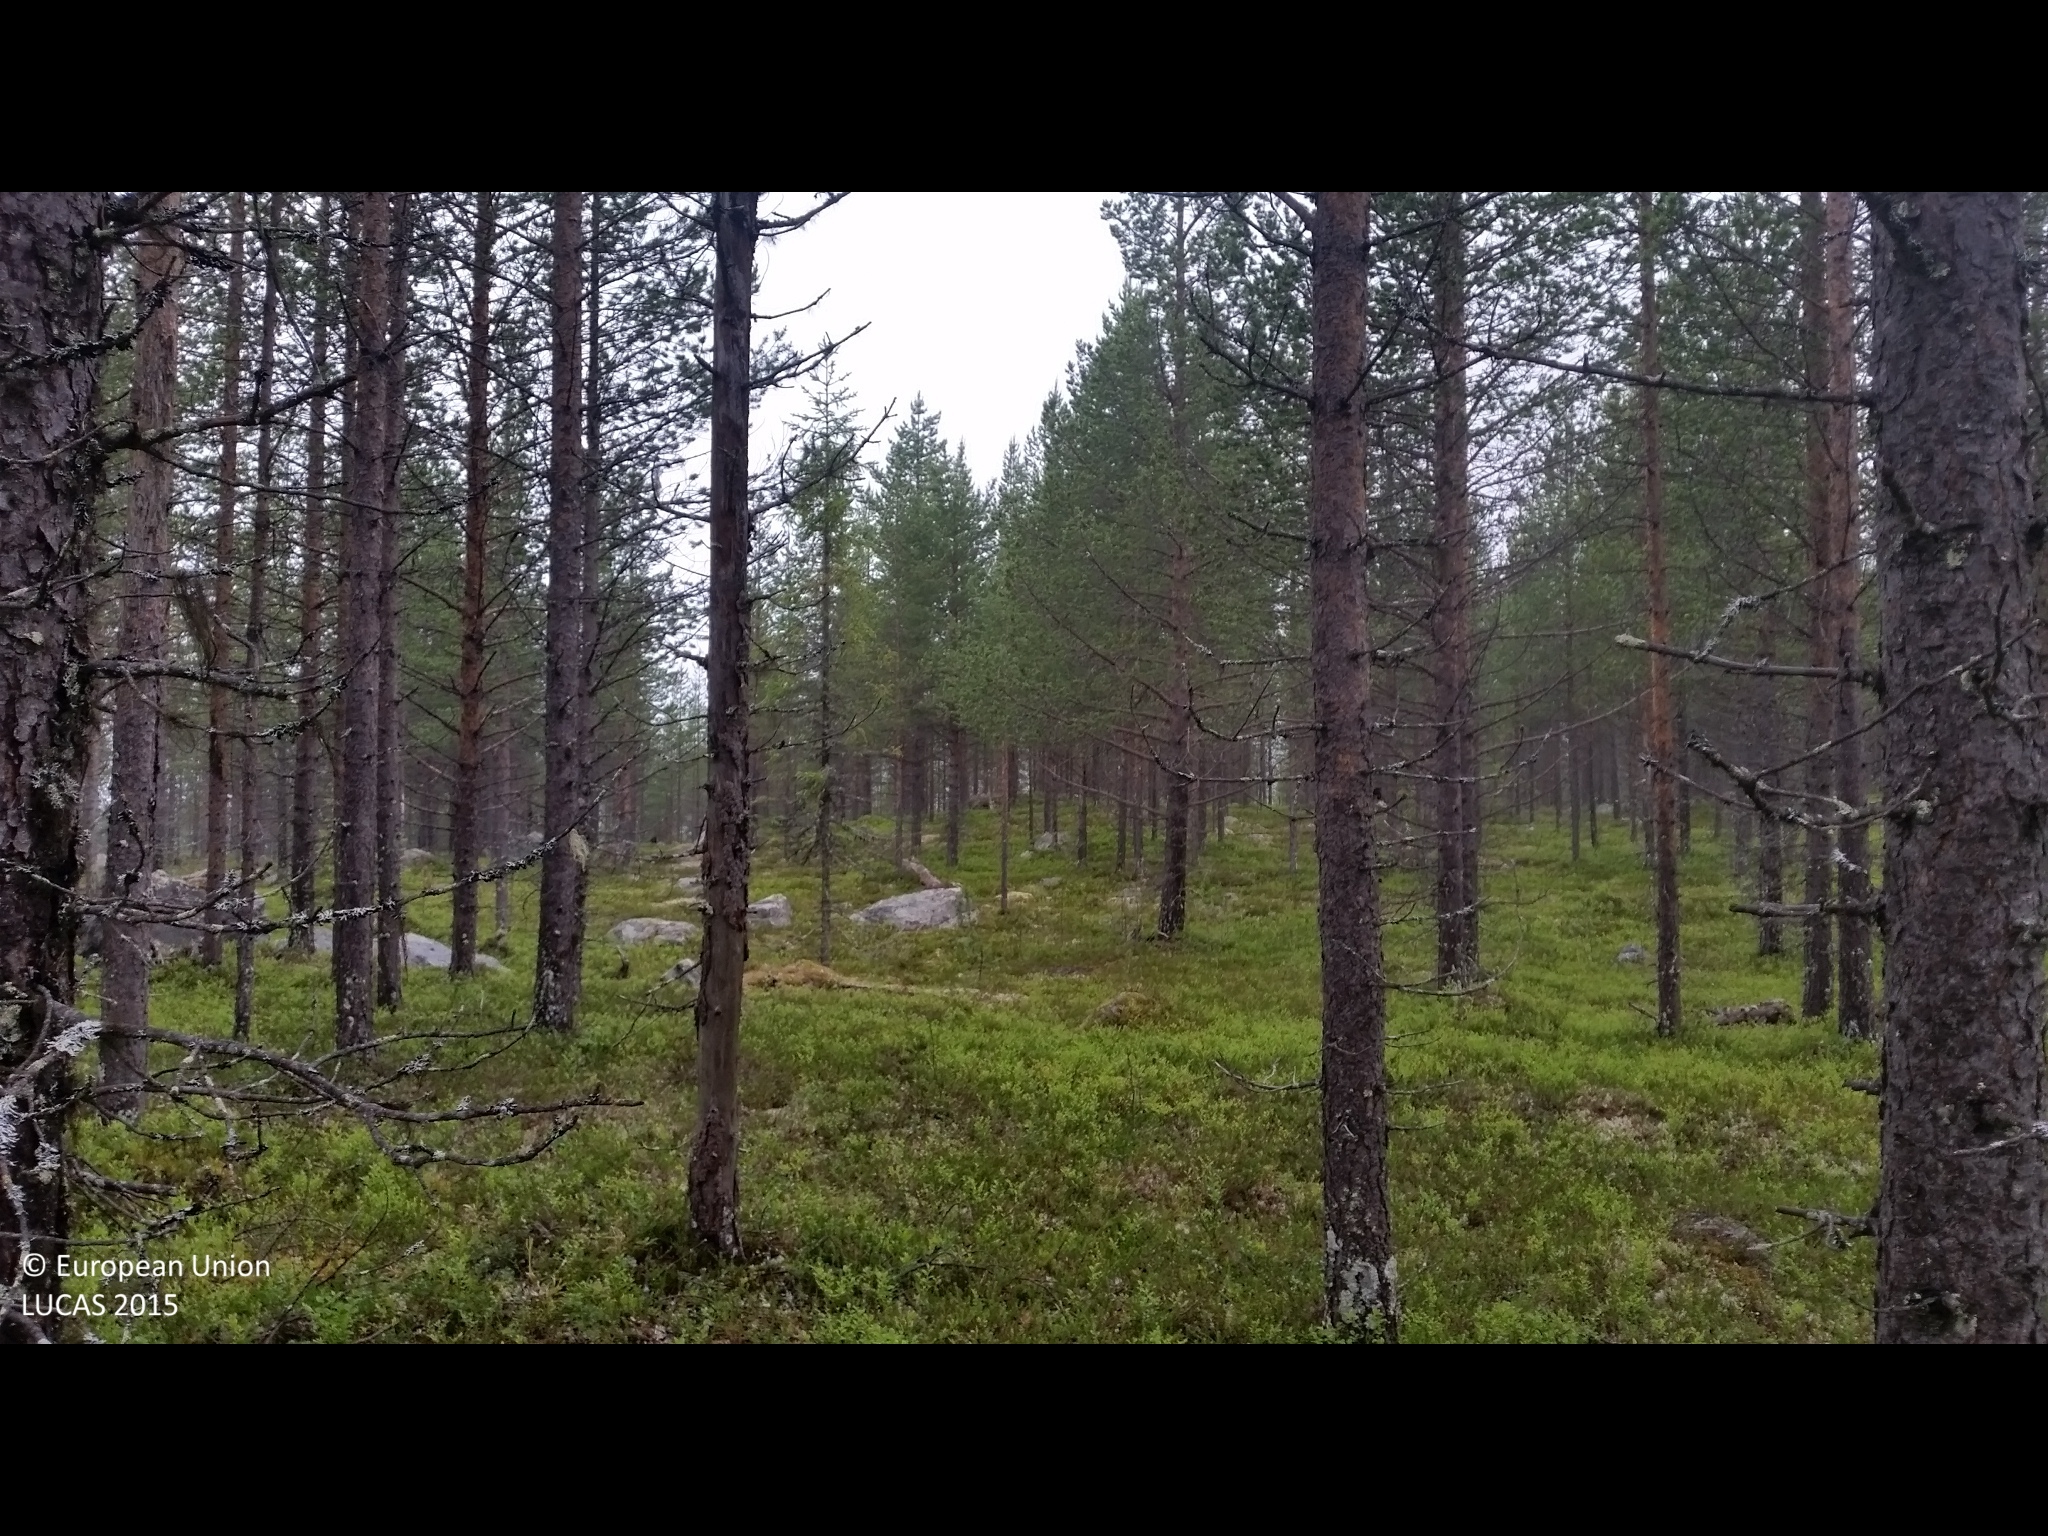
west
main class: Woodland
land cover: Pine dominated coniferous woodland
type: boreal forest
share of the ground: 50 - 75 %
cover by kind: coniferous forest trees 65 %, shrubs 25 %, lichens and mosses 5 %, consolidated bare surface 5 %
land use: Forestry
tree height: > 5 m
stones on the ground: > 50 %
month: July
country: SE
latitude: 65.8823
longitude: 18.0934
